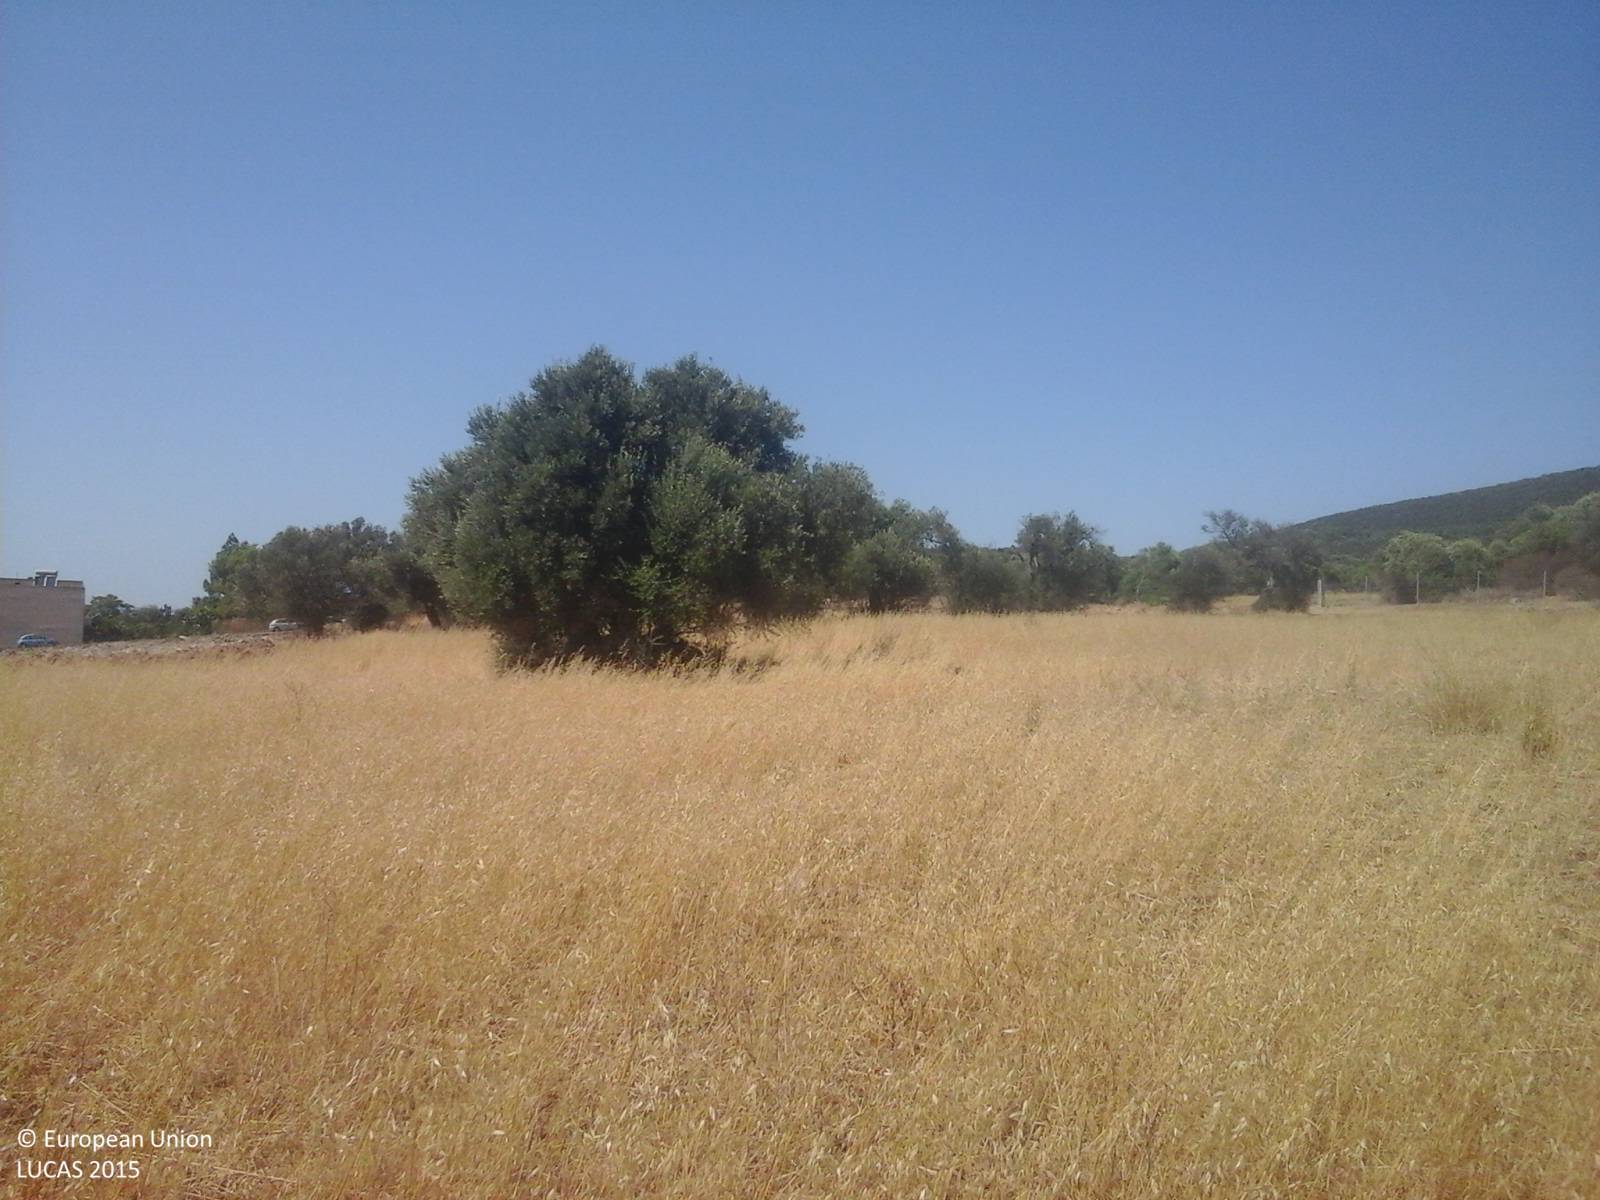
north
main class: Cropland
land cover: Oats
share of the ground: > 75 %
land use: Agriculture (excluding fallow land and kitchen gardens)
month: June
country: IT
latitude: 39.0440
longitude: 8.6338
